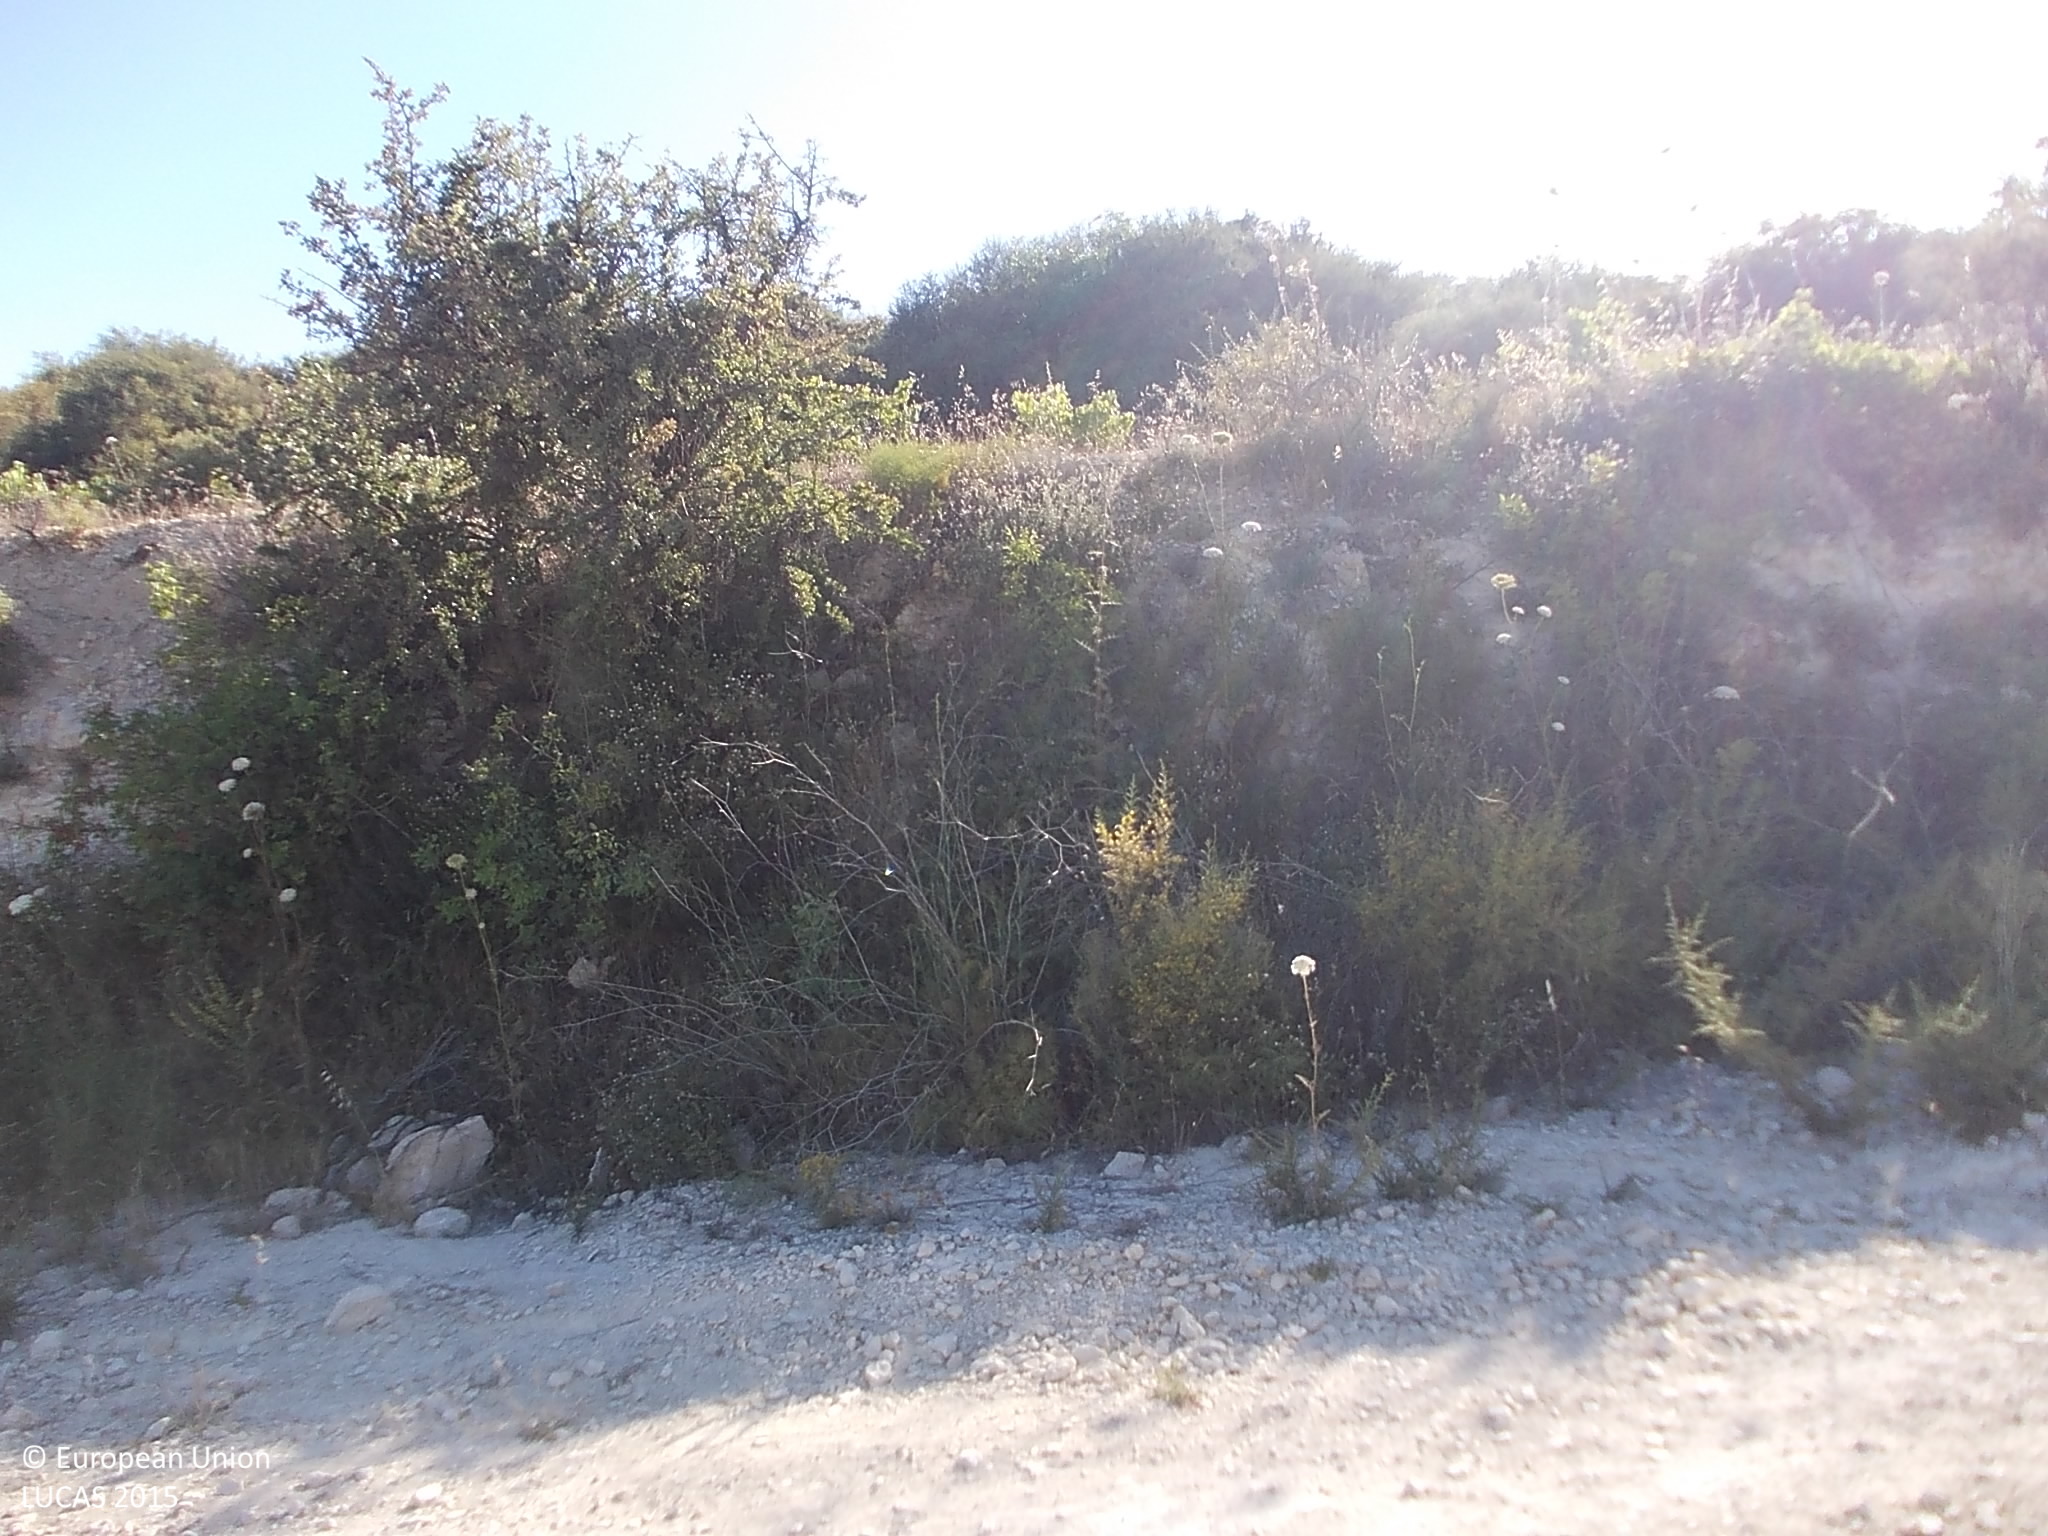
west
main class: Shrubland
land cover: Shrubland without tree cover
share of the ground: 50 - 75 %
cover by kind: shrubs 65 %, unconsolidated bare surface 20 %, herbaceous plants 15 %
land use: Semi-natural and natural areas not in use
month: July
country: CY
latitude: 34.8372
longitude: 32.8304
